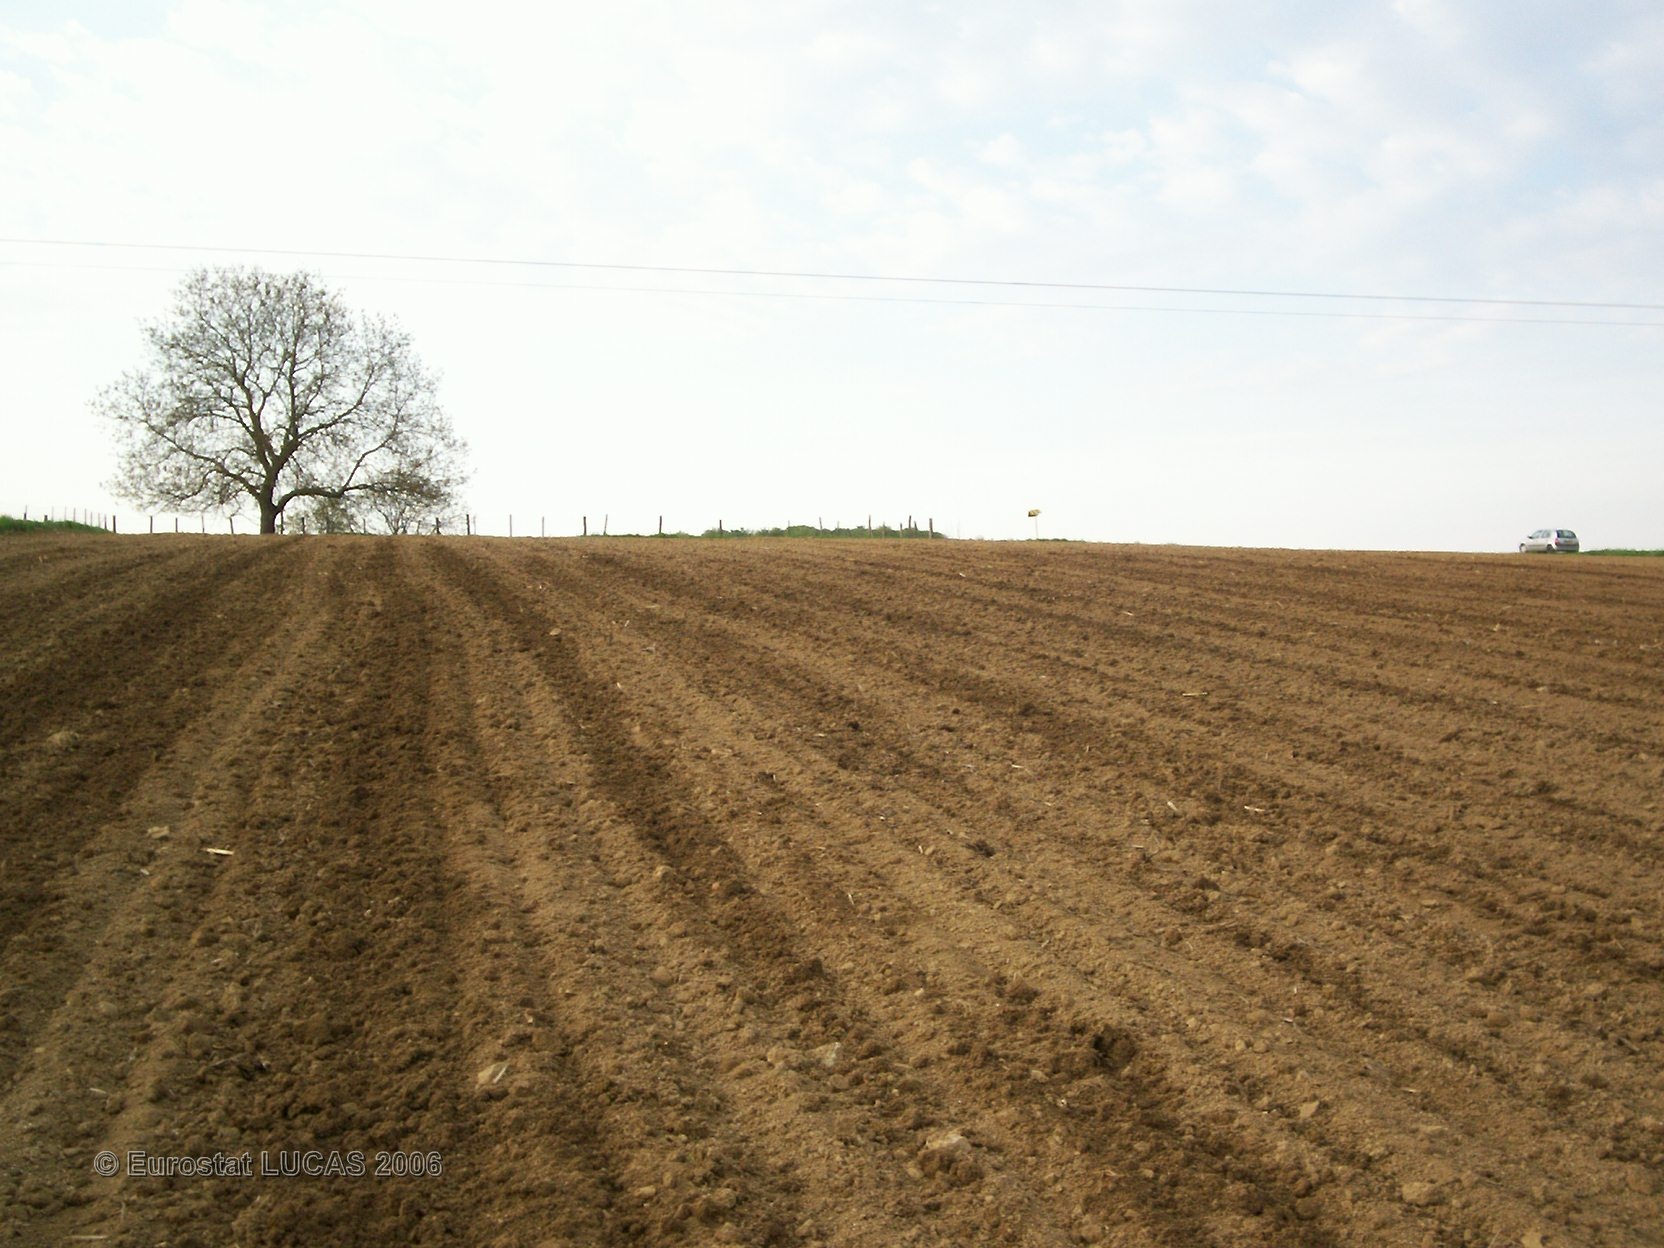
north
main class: Cropland
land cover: Maize
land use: Agriculture (excluding fallow land and kitchen gardens)
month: May
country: FR
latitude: 47.6289
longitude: 7.1670
